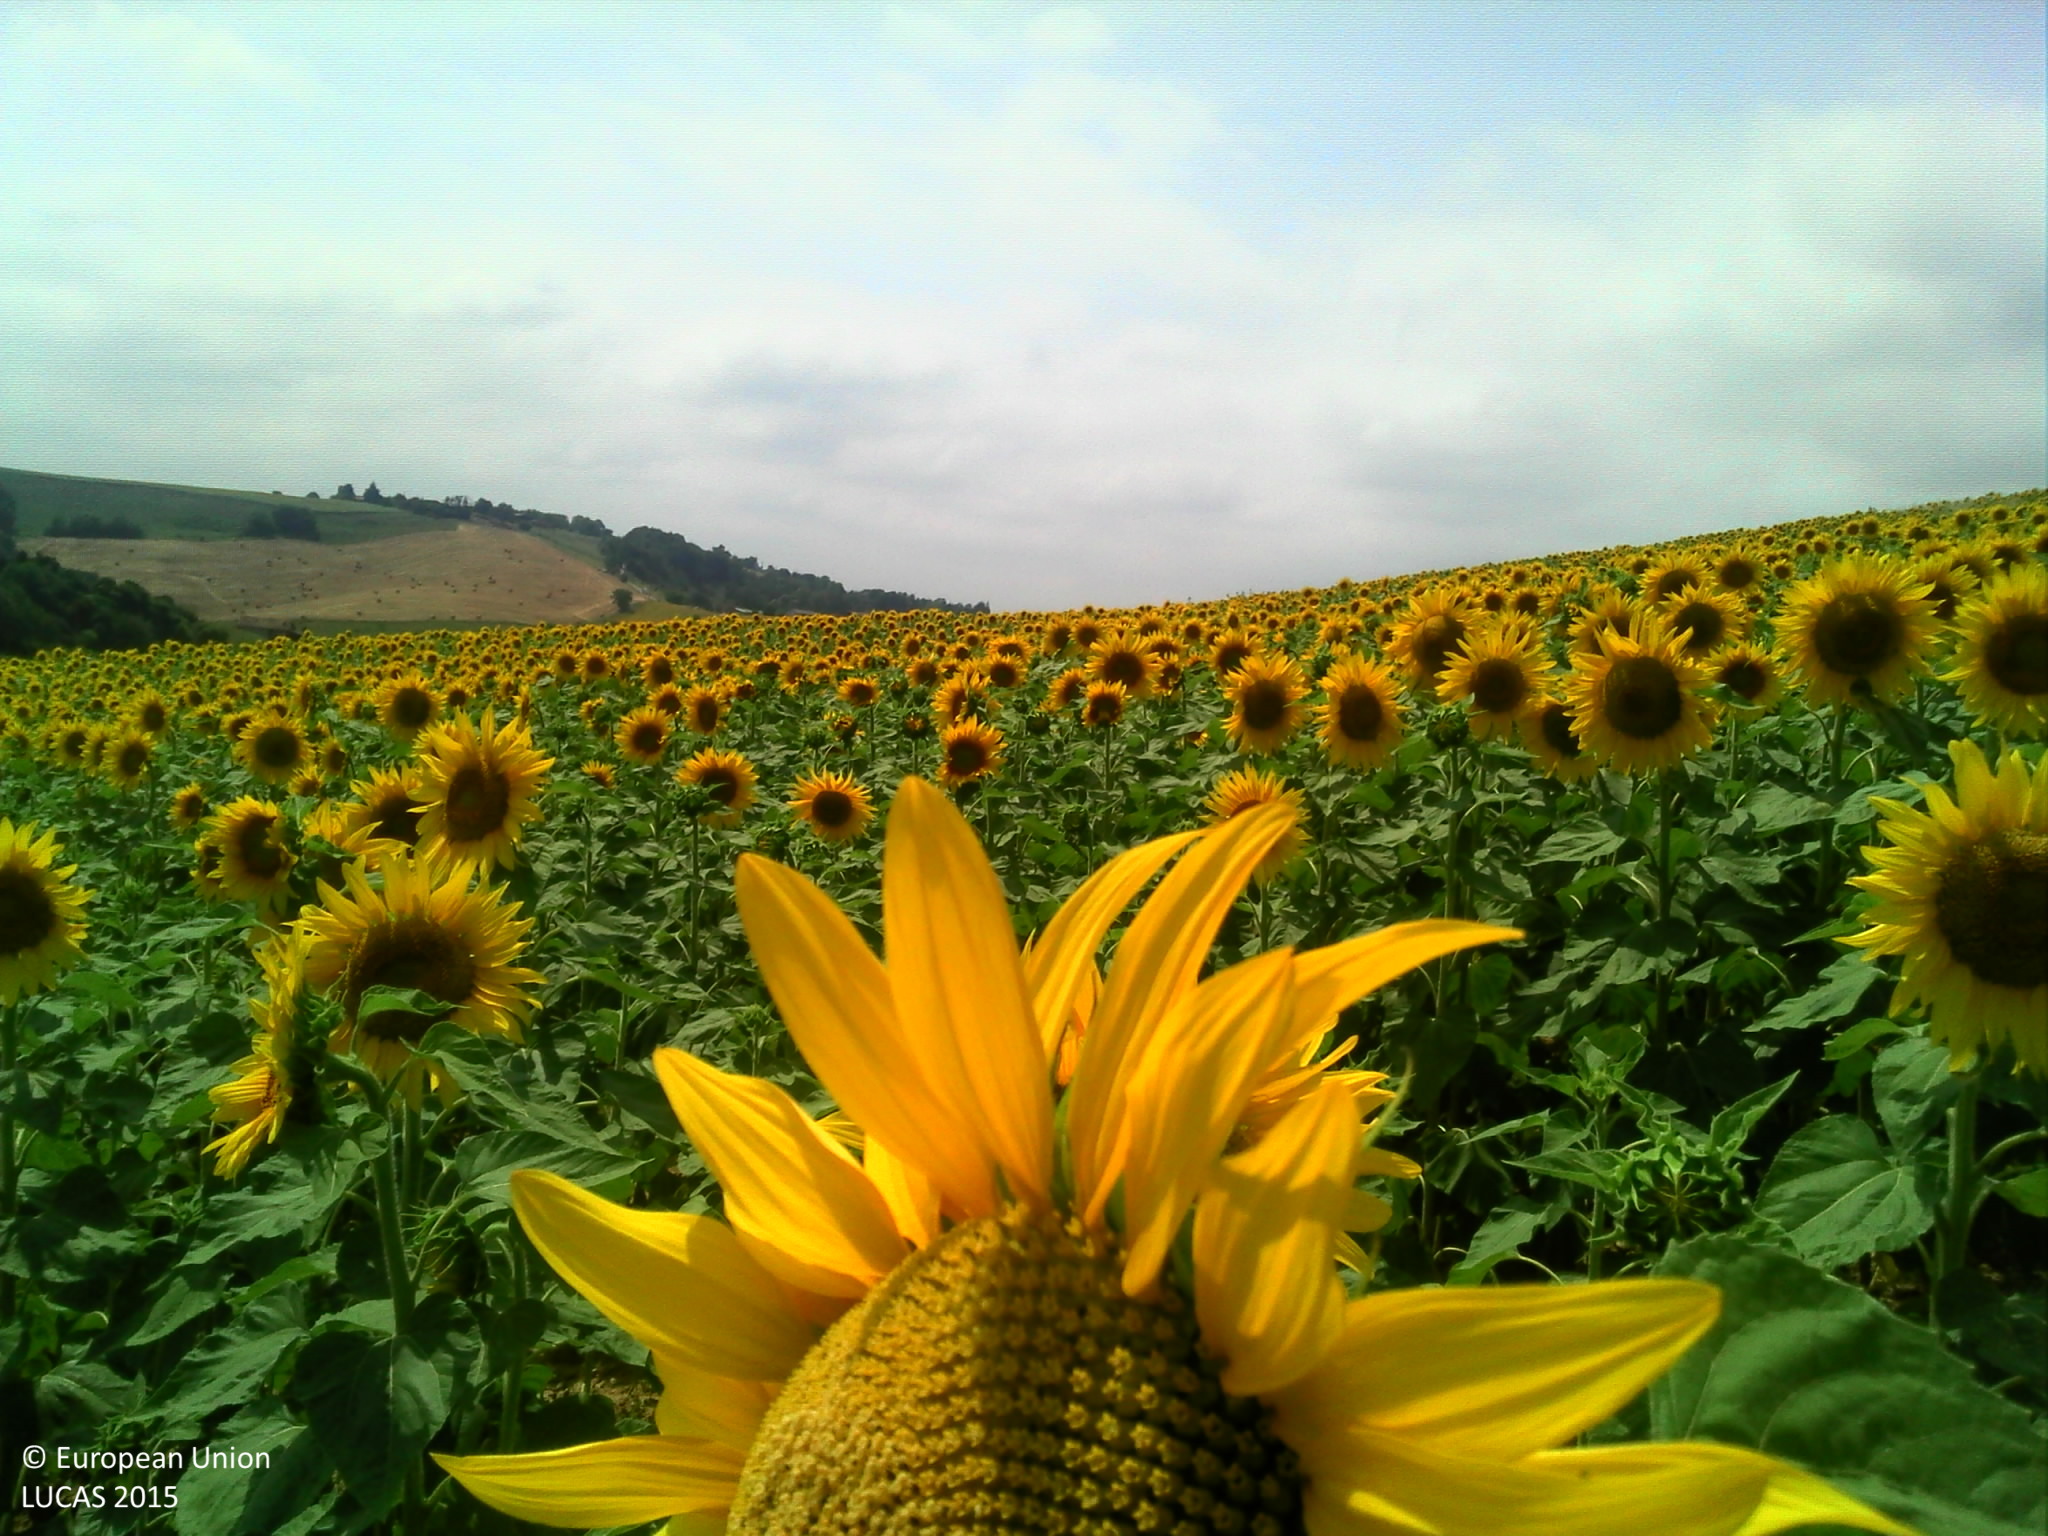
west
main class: Cropland
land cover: Sunflower
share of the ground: > 75 %
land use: Agriculture (excluding fallow land and kitchen gardens)
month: July
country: FR
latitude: 43.3764
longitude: 0.9793
